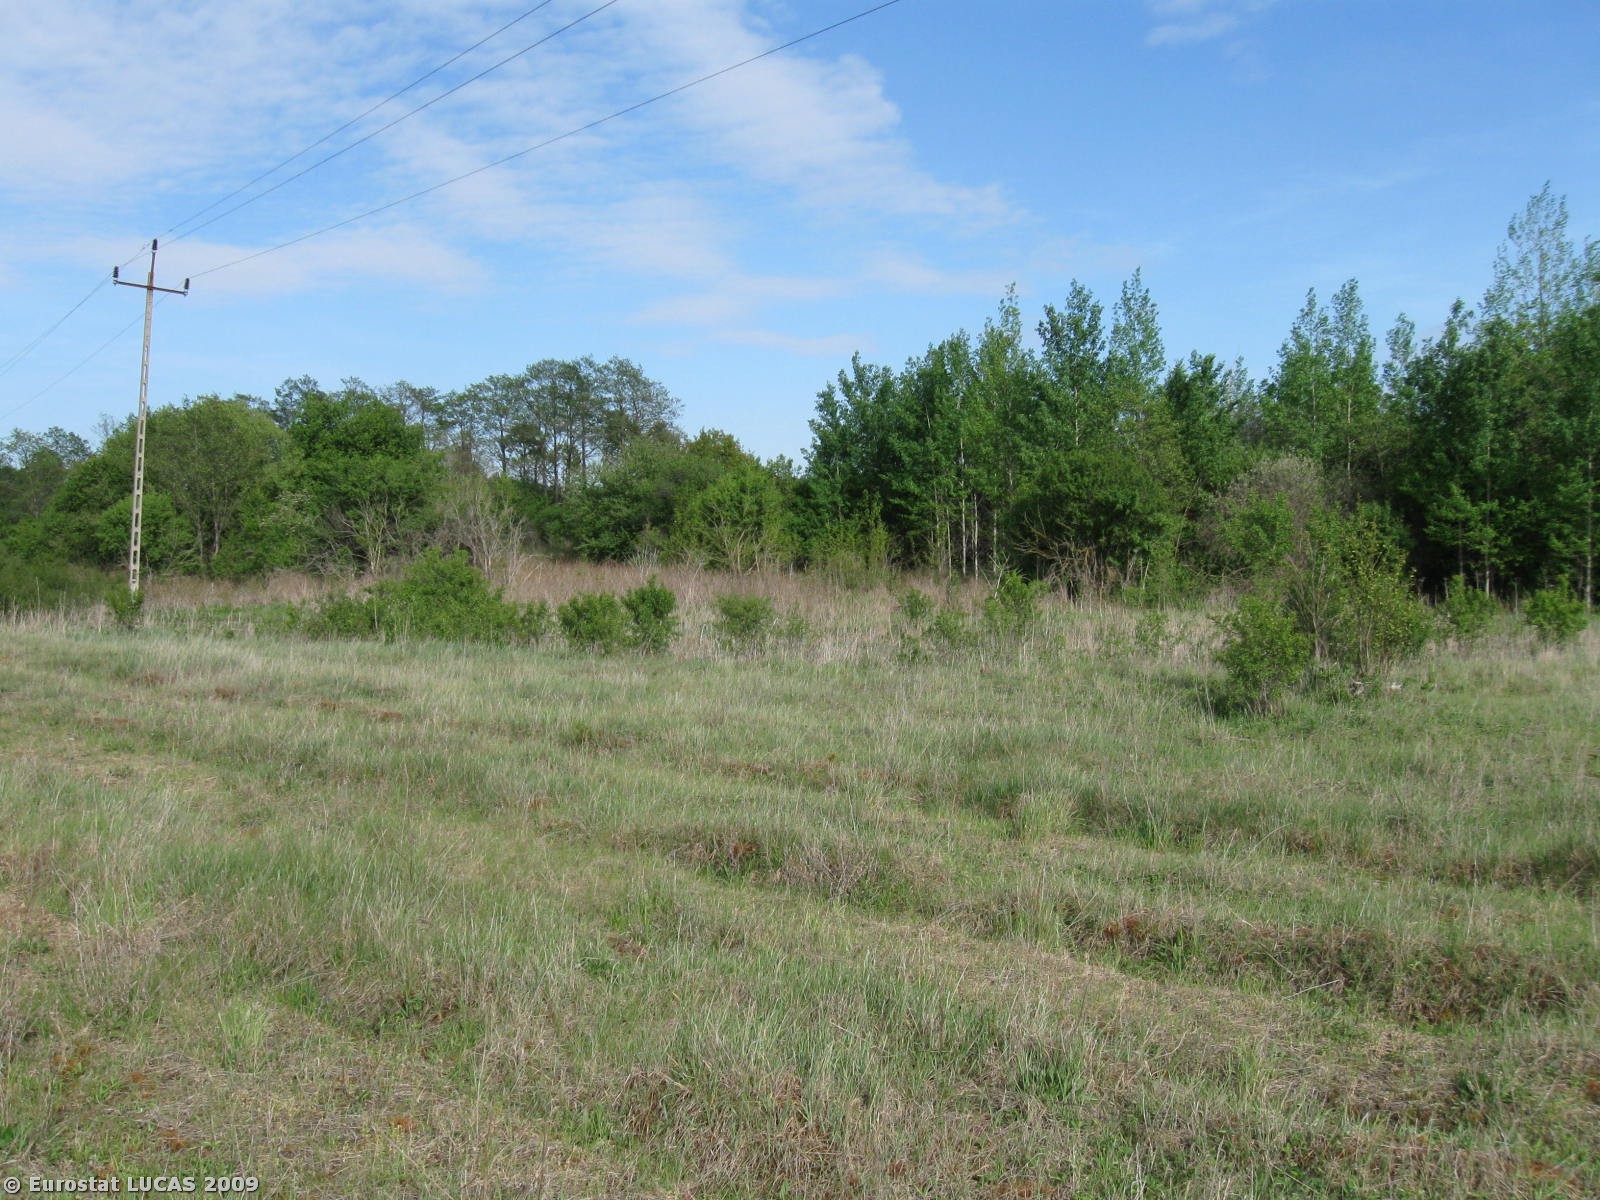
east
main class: Grassland
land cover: Grassland without tree/shrub cover
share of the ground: > 75 %
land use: Agriculture (excluding fallow land and kitchen gardens)
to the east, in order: Grassland without tree/shrub cover; Electric lines; Grassland with sparse tree/shrub cover; Groves; Grassland without tree/shrub cover; Broadleaved woodland; Grassland without tree/shrub cover
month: May
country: PL
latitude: 50.8504
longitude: 20.3917
